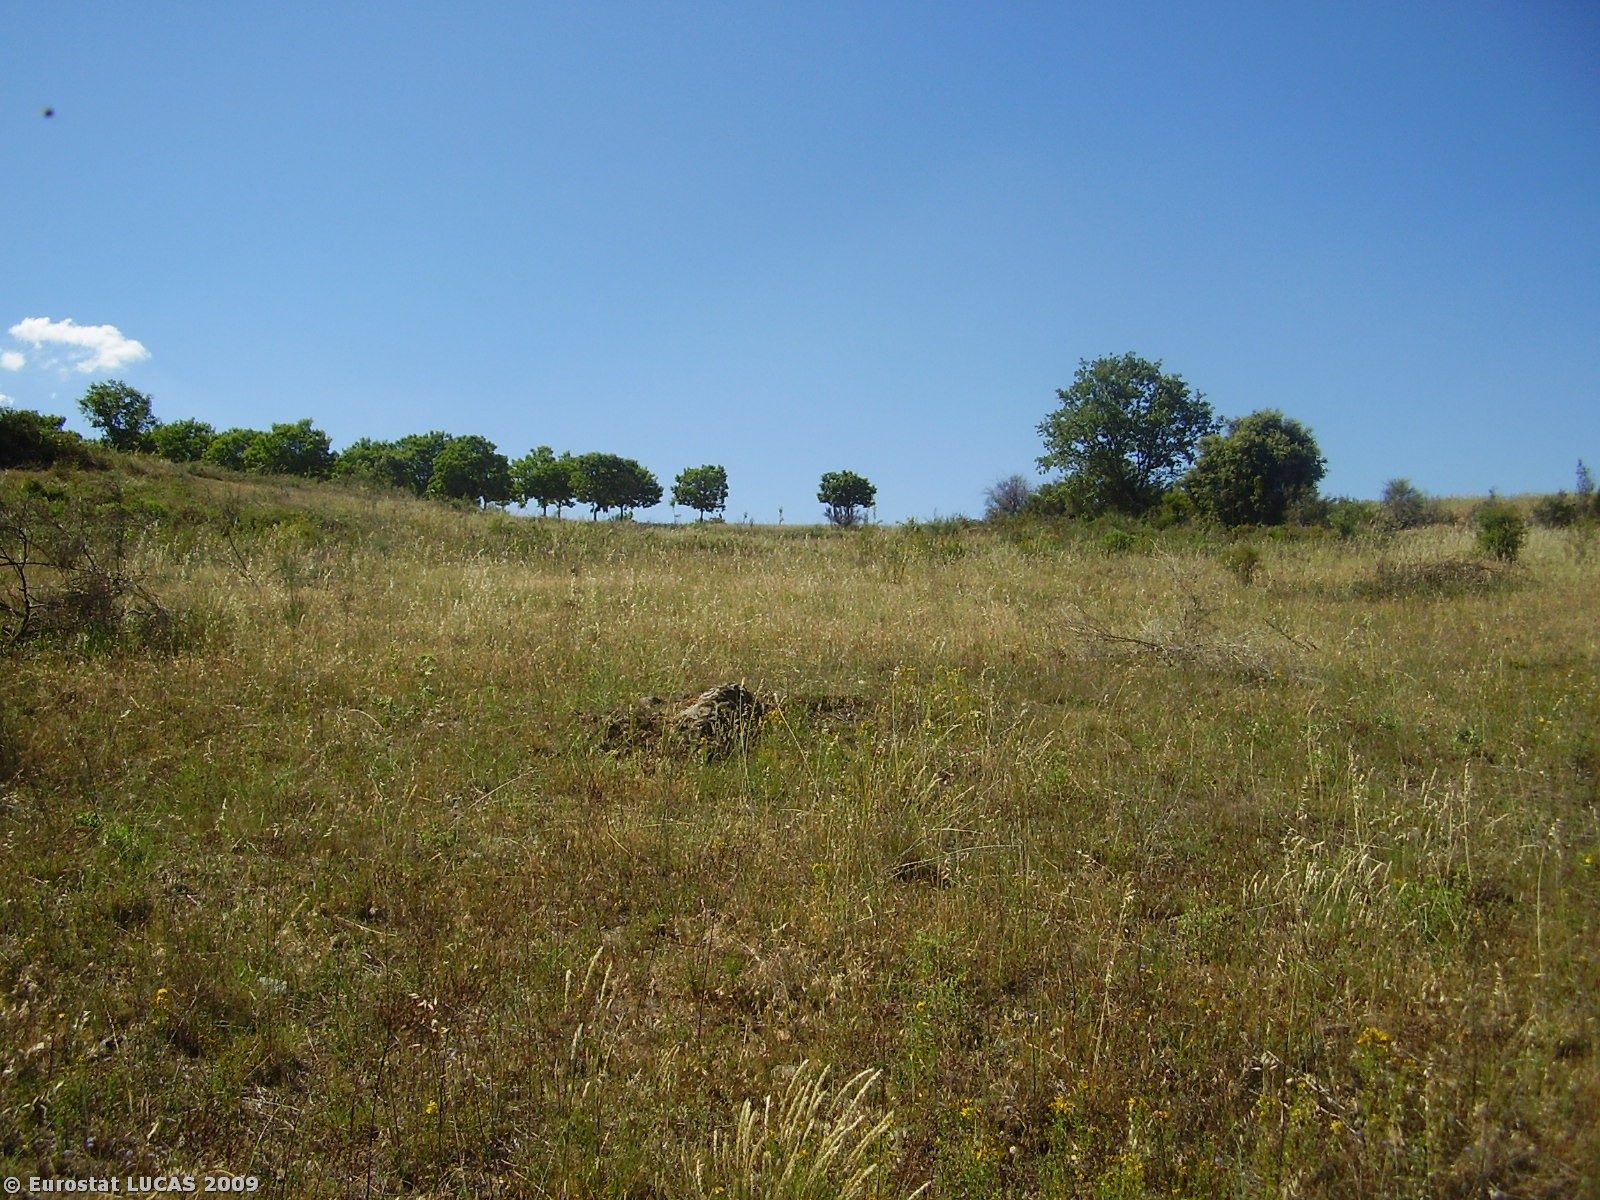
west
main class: Grassland
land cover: Spontaneously vegetated surfaces
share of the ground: > 75 %
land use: Nature reserves
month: June
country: PT
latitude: 41.7735
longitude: -6.5778
